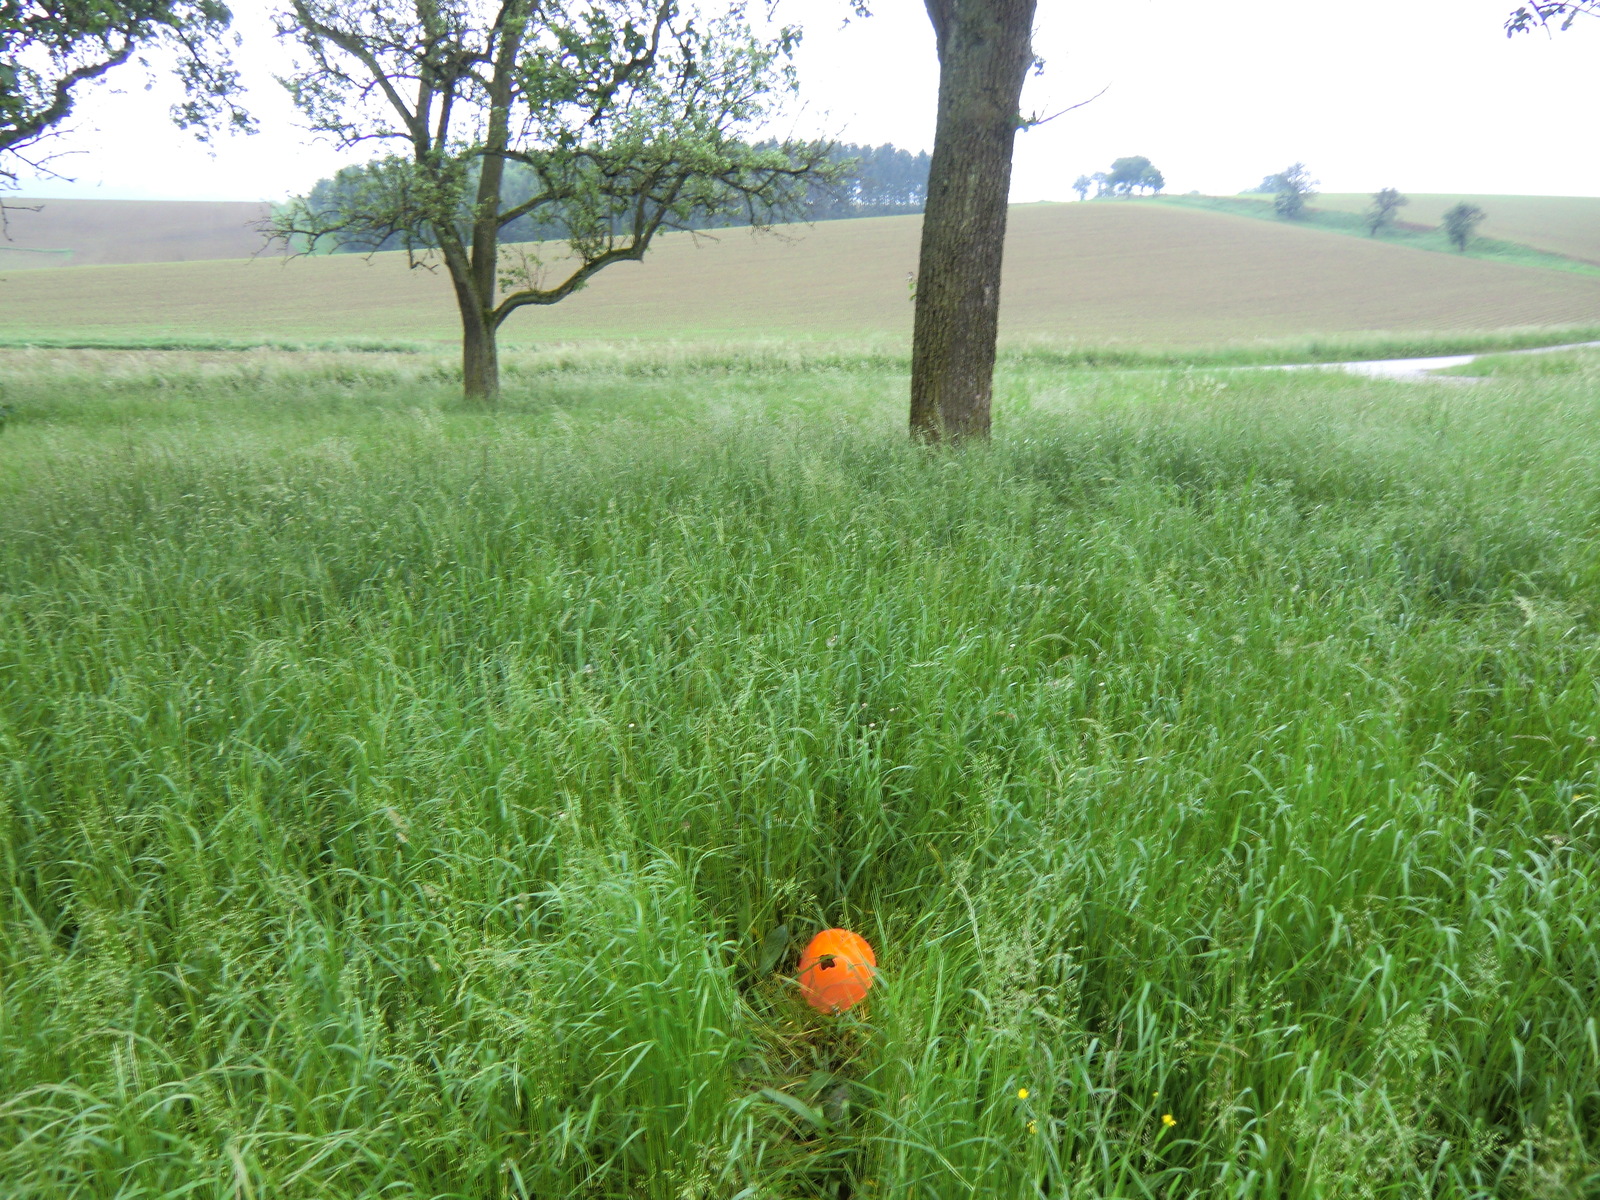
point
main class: Cropland
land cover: Pear fruit
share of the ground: 50 - 75 %
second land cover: Grassland without tree/shrub cover
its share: > 75 %
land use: Agriculture (excluding fallow land and kitchen gardens)
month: May
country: AT
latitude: 48.1265
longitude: 15.4164
